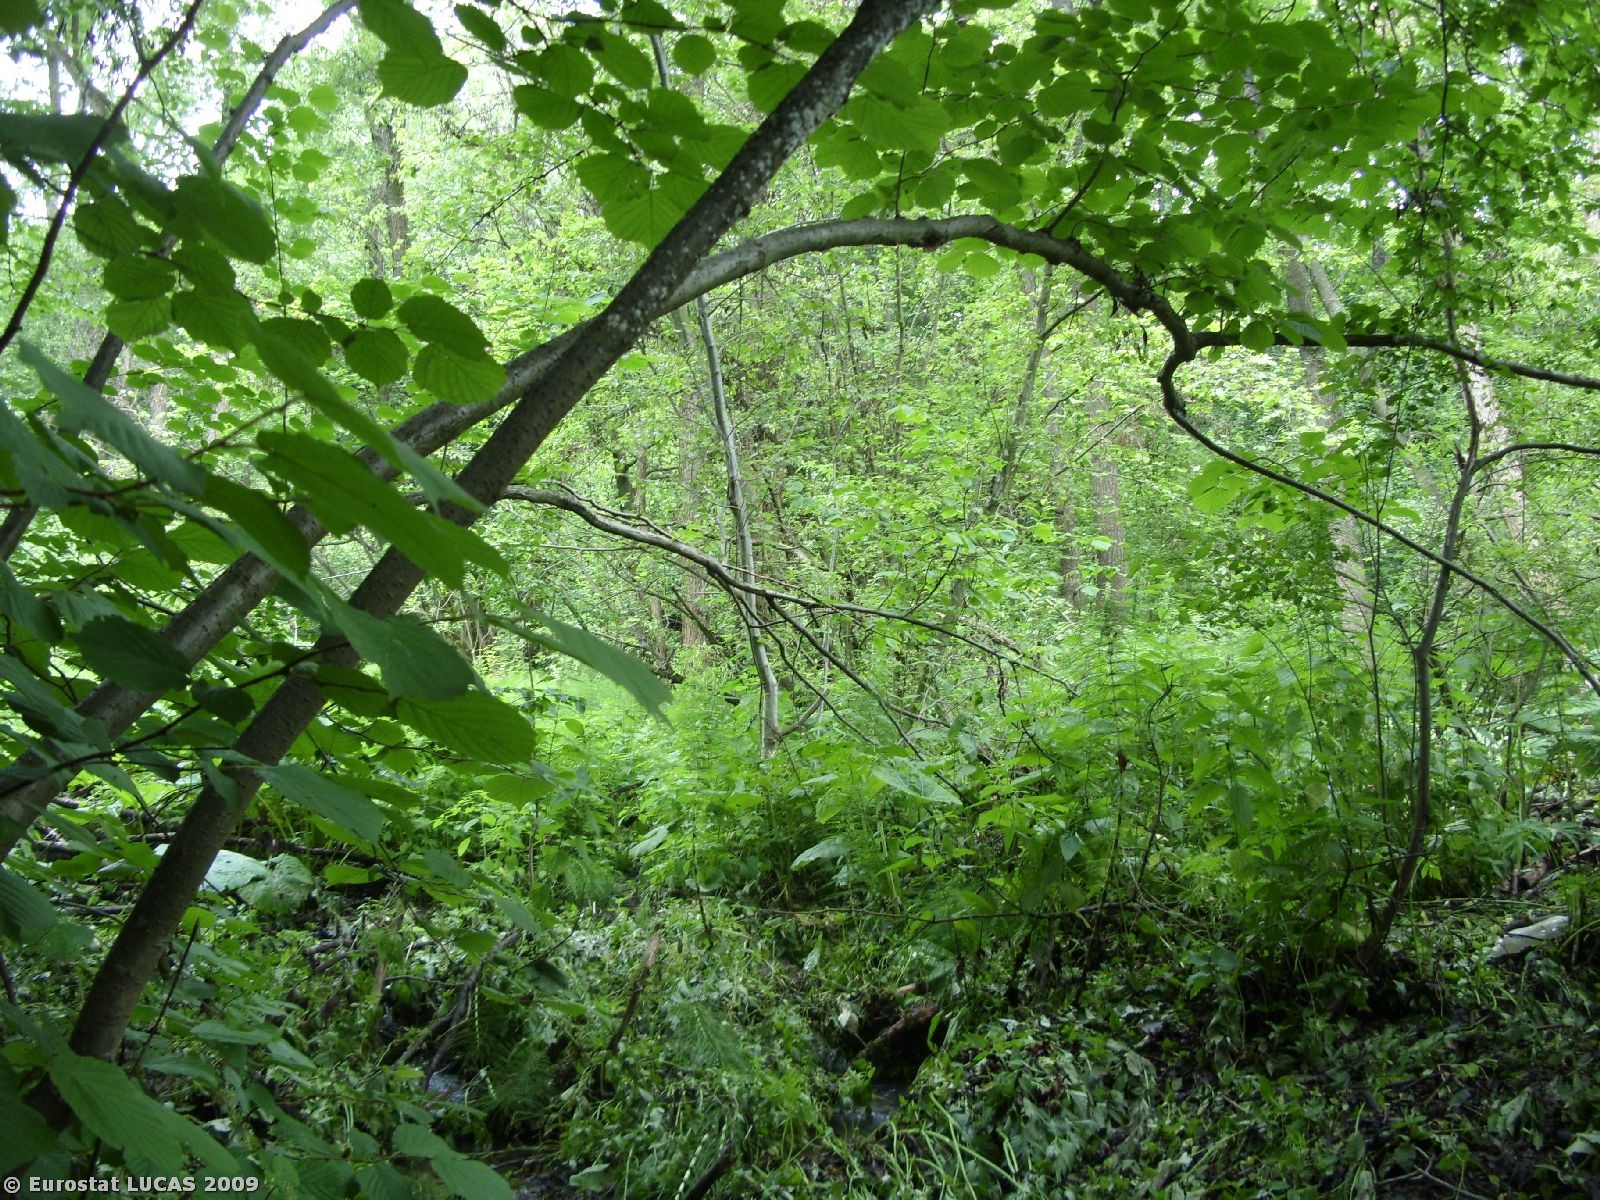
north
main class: Woodland
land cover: Broadleaved woodland
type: mesophytic deciduous forest
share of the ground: > 75 %
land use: Unused
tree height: > 5 m
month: June
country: PL
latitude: 49.8371
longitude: 20.1698
